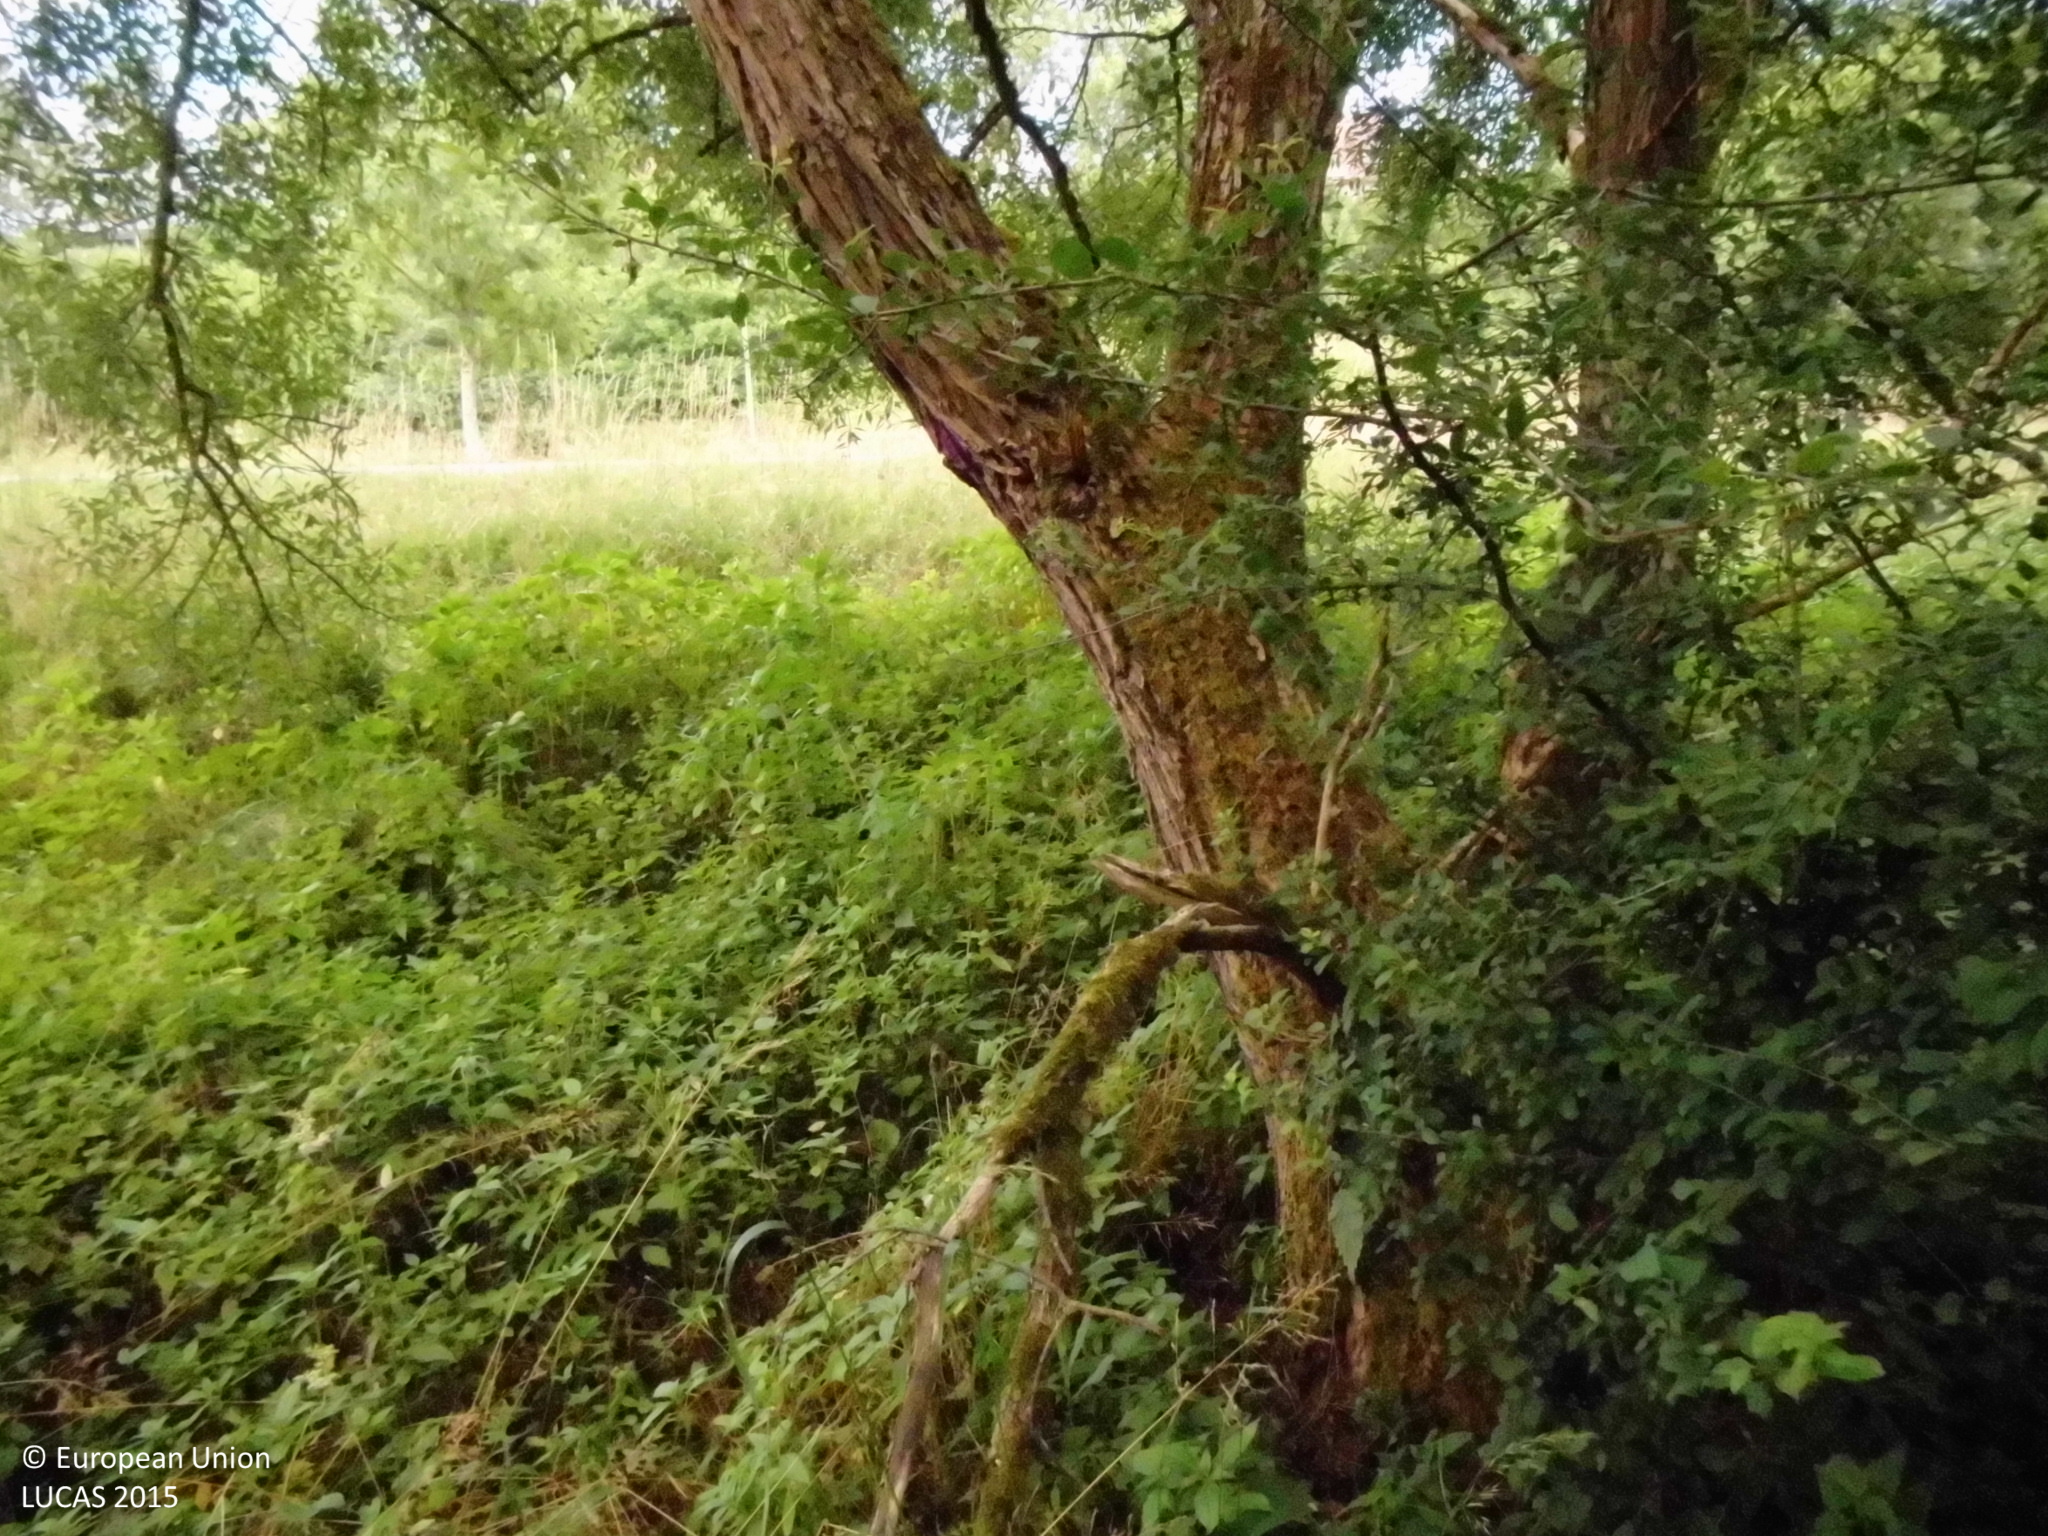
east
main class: Grassland
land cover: Grassland without tree/shrub cover
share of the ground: > 75 %
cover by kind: herbaceous plants 100 %
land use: Agriculture (excluding fallow land and kitchen gardens)
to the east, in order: Grassland without tree/shrub cover; Broadleaved woodland; Inland fresh running water; Broadleaved woodland; Grassland without tree/shrub cover; Paved roads, cycling and walking lanes; Grassland without tree/shrub cover; Lines of trees; Shruby margins; Fences; Grassland without tree/shrub cover; Shrubland with sparse tree cover; Artificial constructions in urban areas
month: July
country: DE
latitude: 50.4793
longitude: 8.4361
